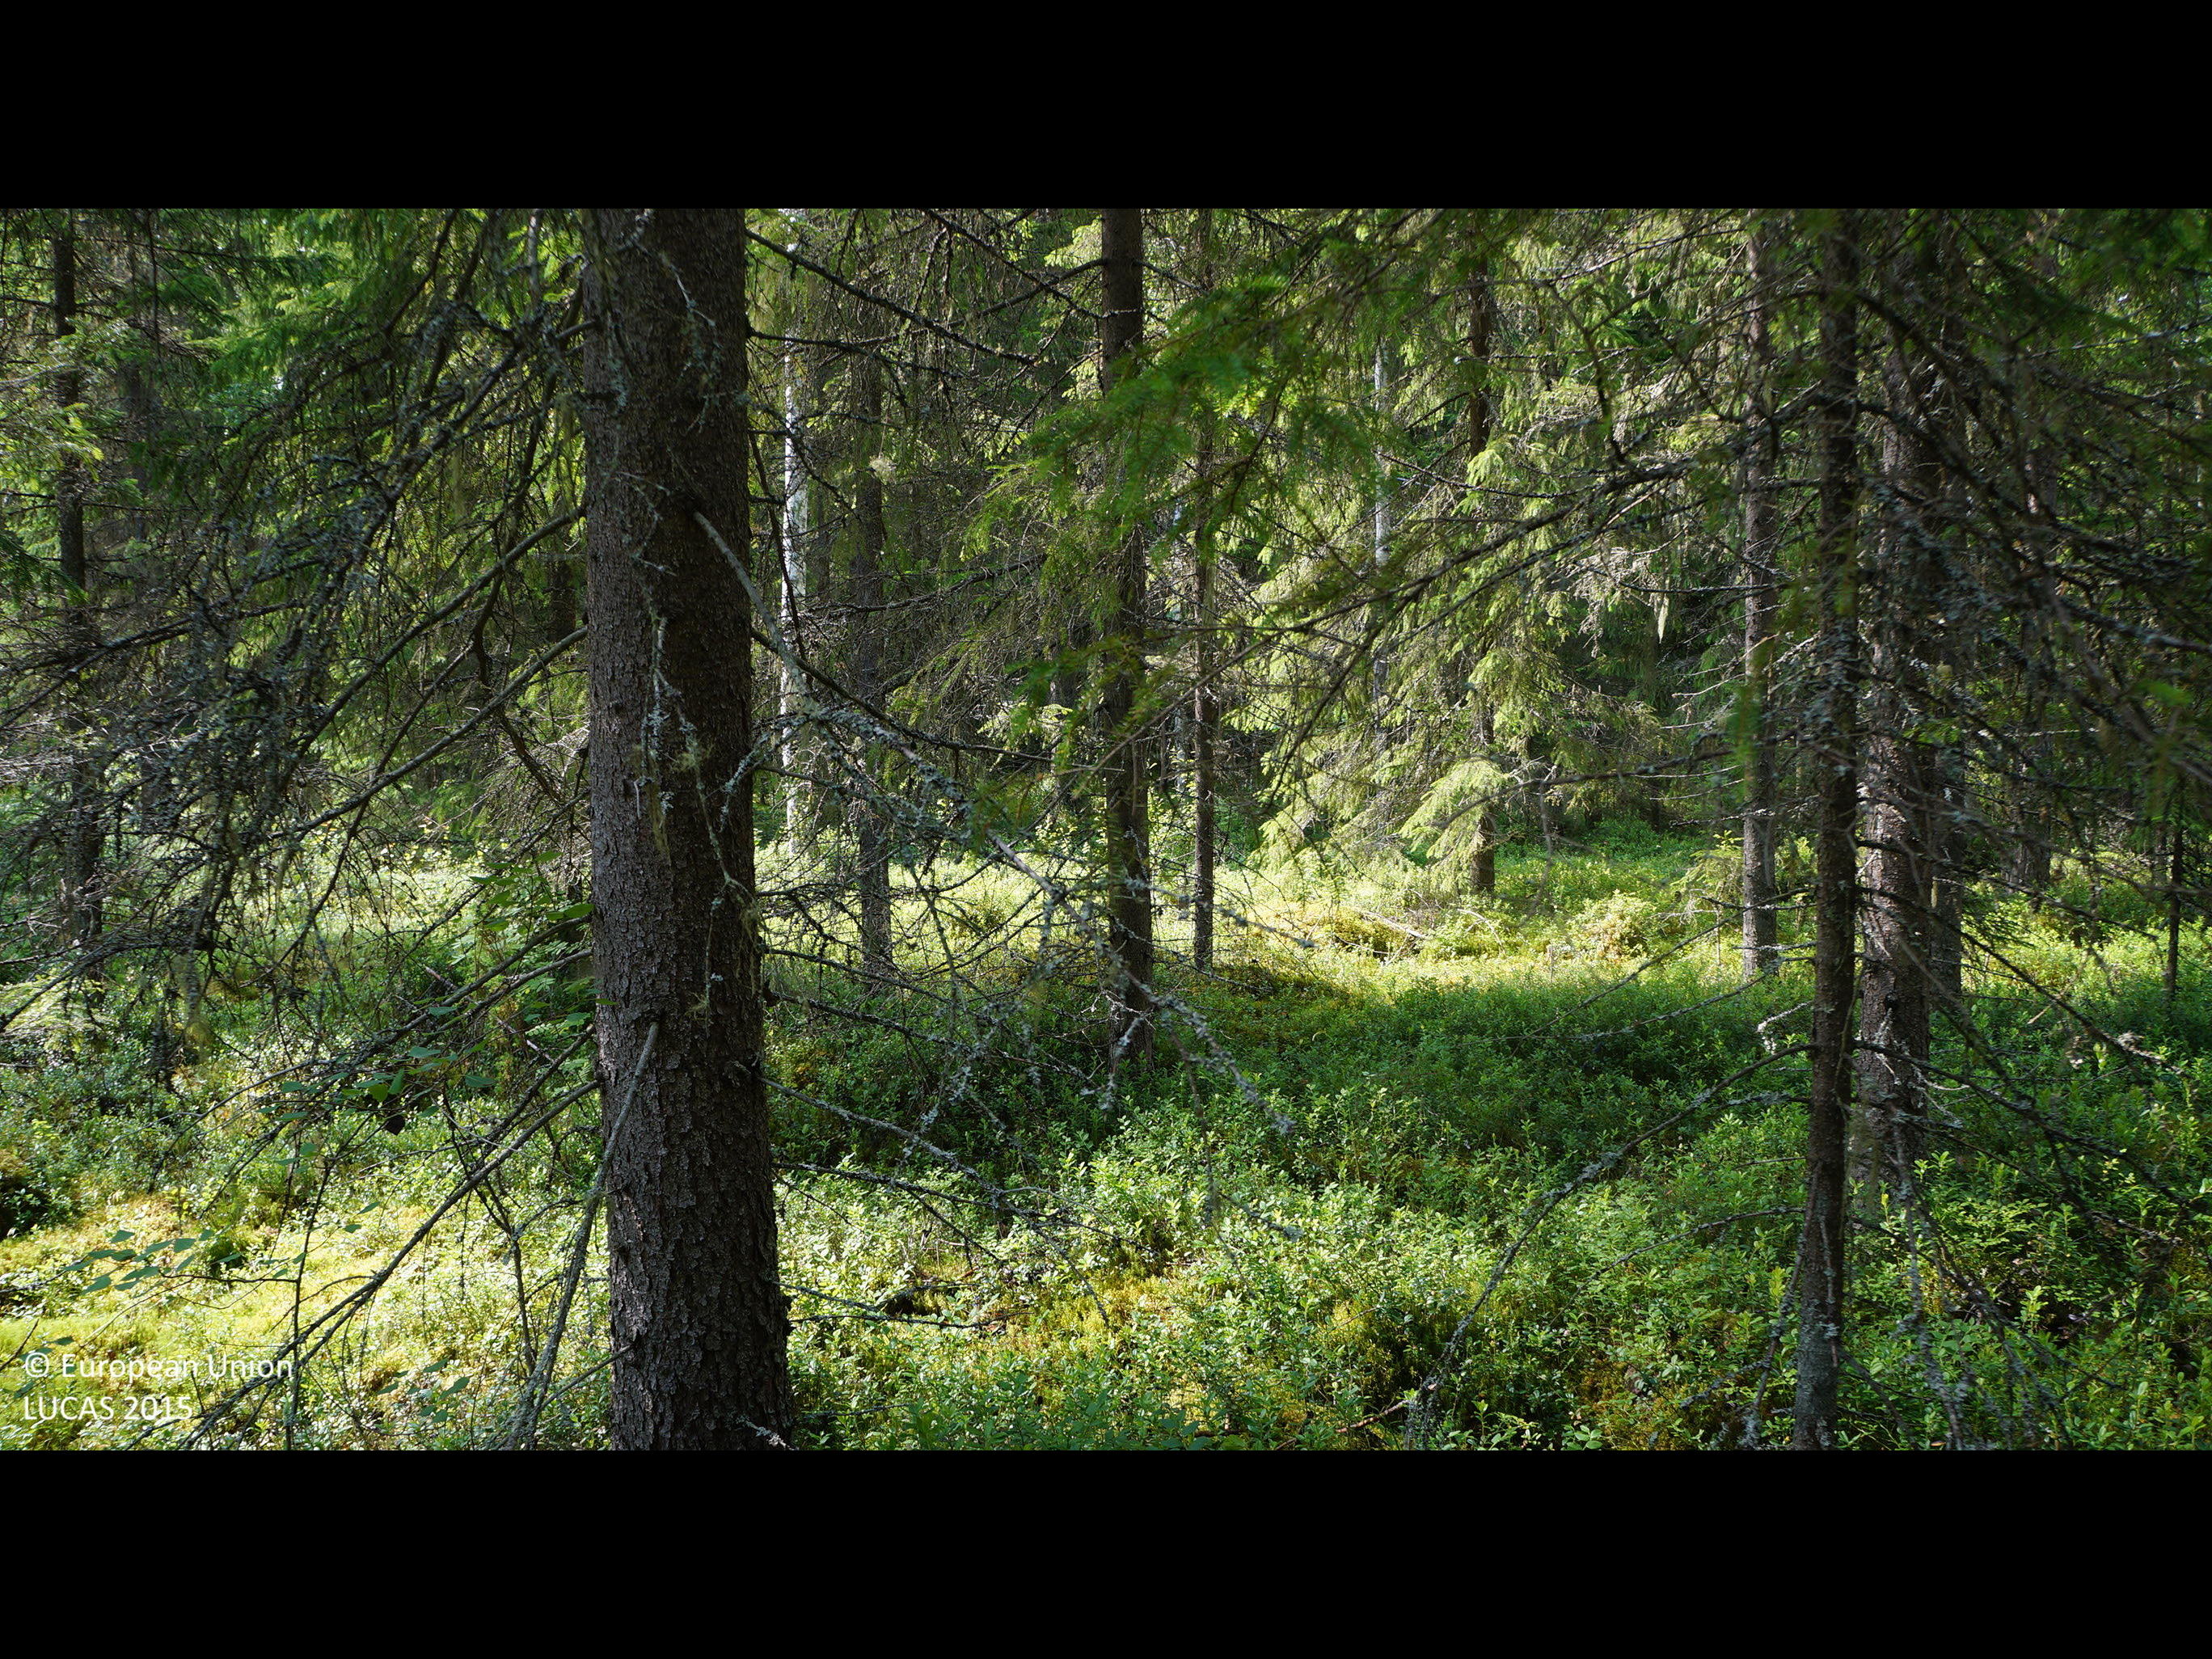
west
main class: Woodland
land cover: Spruce dominated coniferous woodland
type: boreal forest
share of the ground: > 75 %
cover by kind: coniferous forest trees 70 %, shrubs 20 %, broadleaved forest trees 5 %, lichens and mosses 5 %
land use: Forestry
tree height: > 5 m
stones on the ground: < 10 %
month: July
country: FI
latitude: 64.1924
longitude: 24.2527
